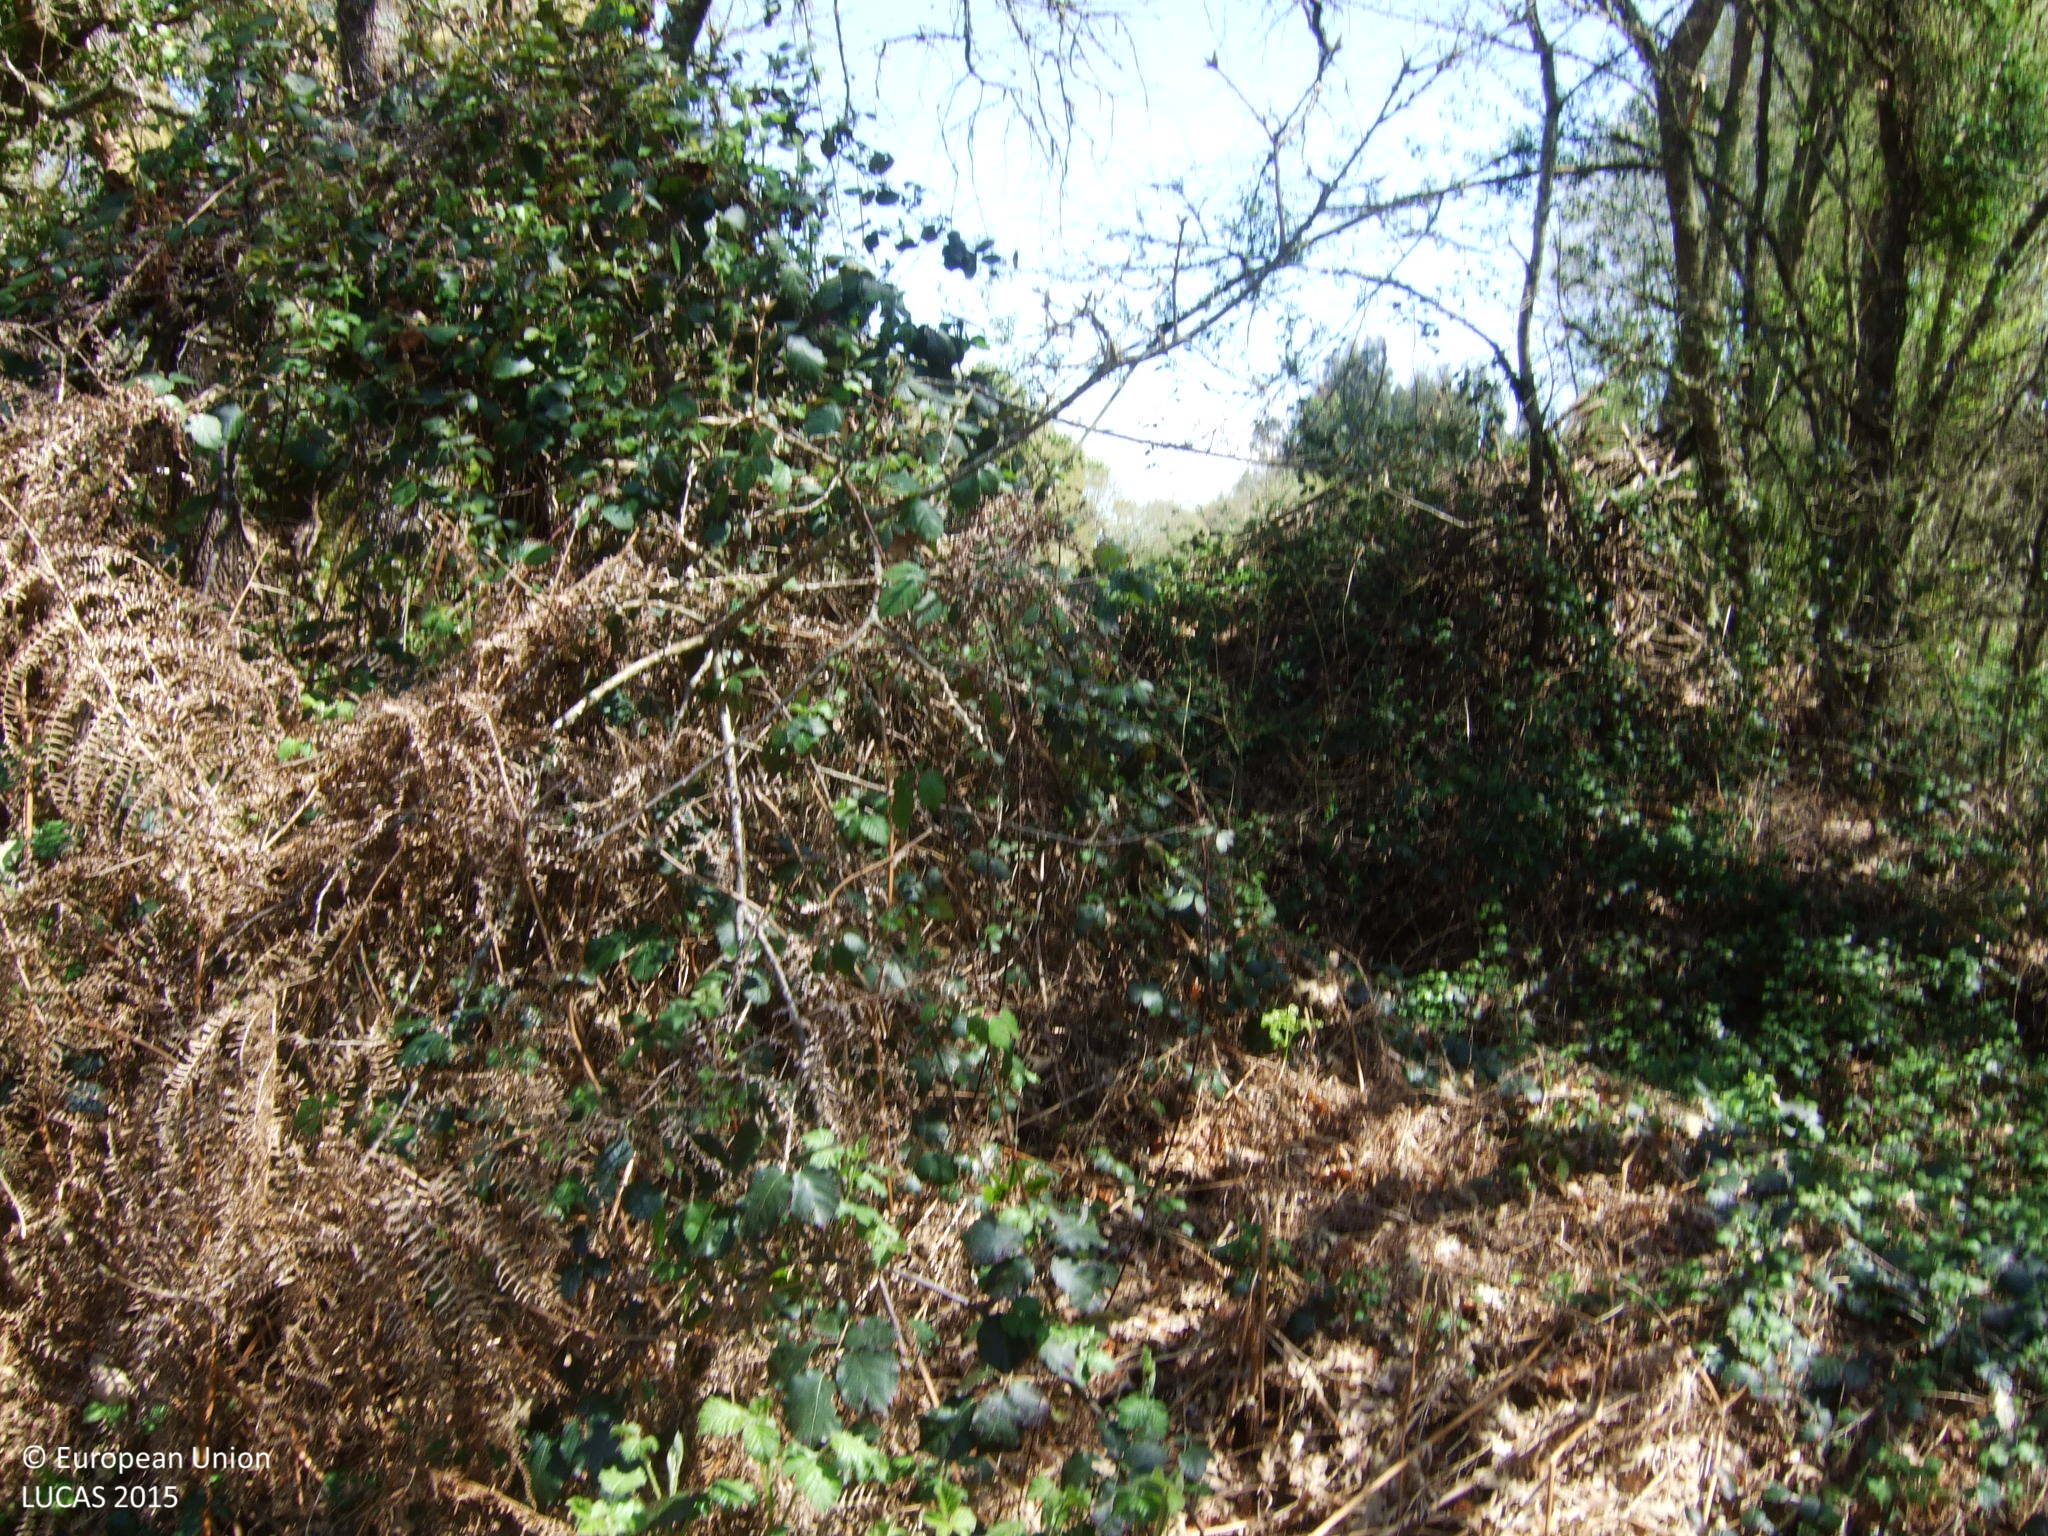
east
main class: Woodland
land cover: Broadleaved woodland
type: acidophilous oak and oak-birch forest
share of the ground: 25 - 50 %
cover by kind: broadleaved forest trees 50 %, shrubs 50 %
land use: Forestry
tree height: > 5 m
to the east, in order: Broadleaved woodland; Temporary grasslands; Shruby margins; Groves; Tracks; Shruby margins; Dry stone walls; Grassland without tree/shrub cover; Groves; Pine dominated coniferous woodland; Fences; Grassland without tree/shrub cover
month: April
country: ES
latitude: 43.0054
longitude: -7.6598
